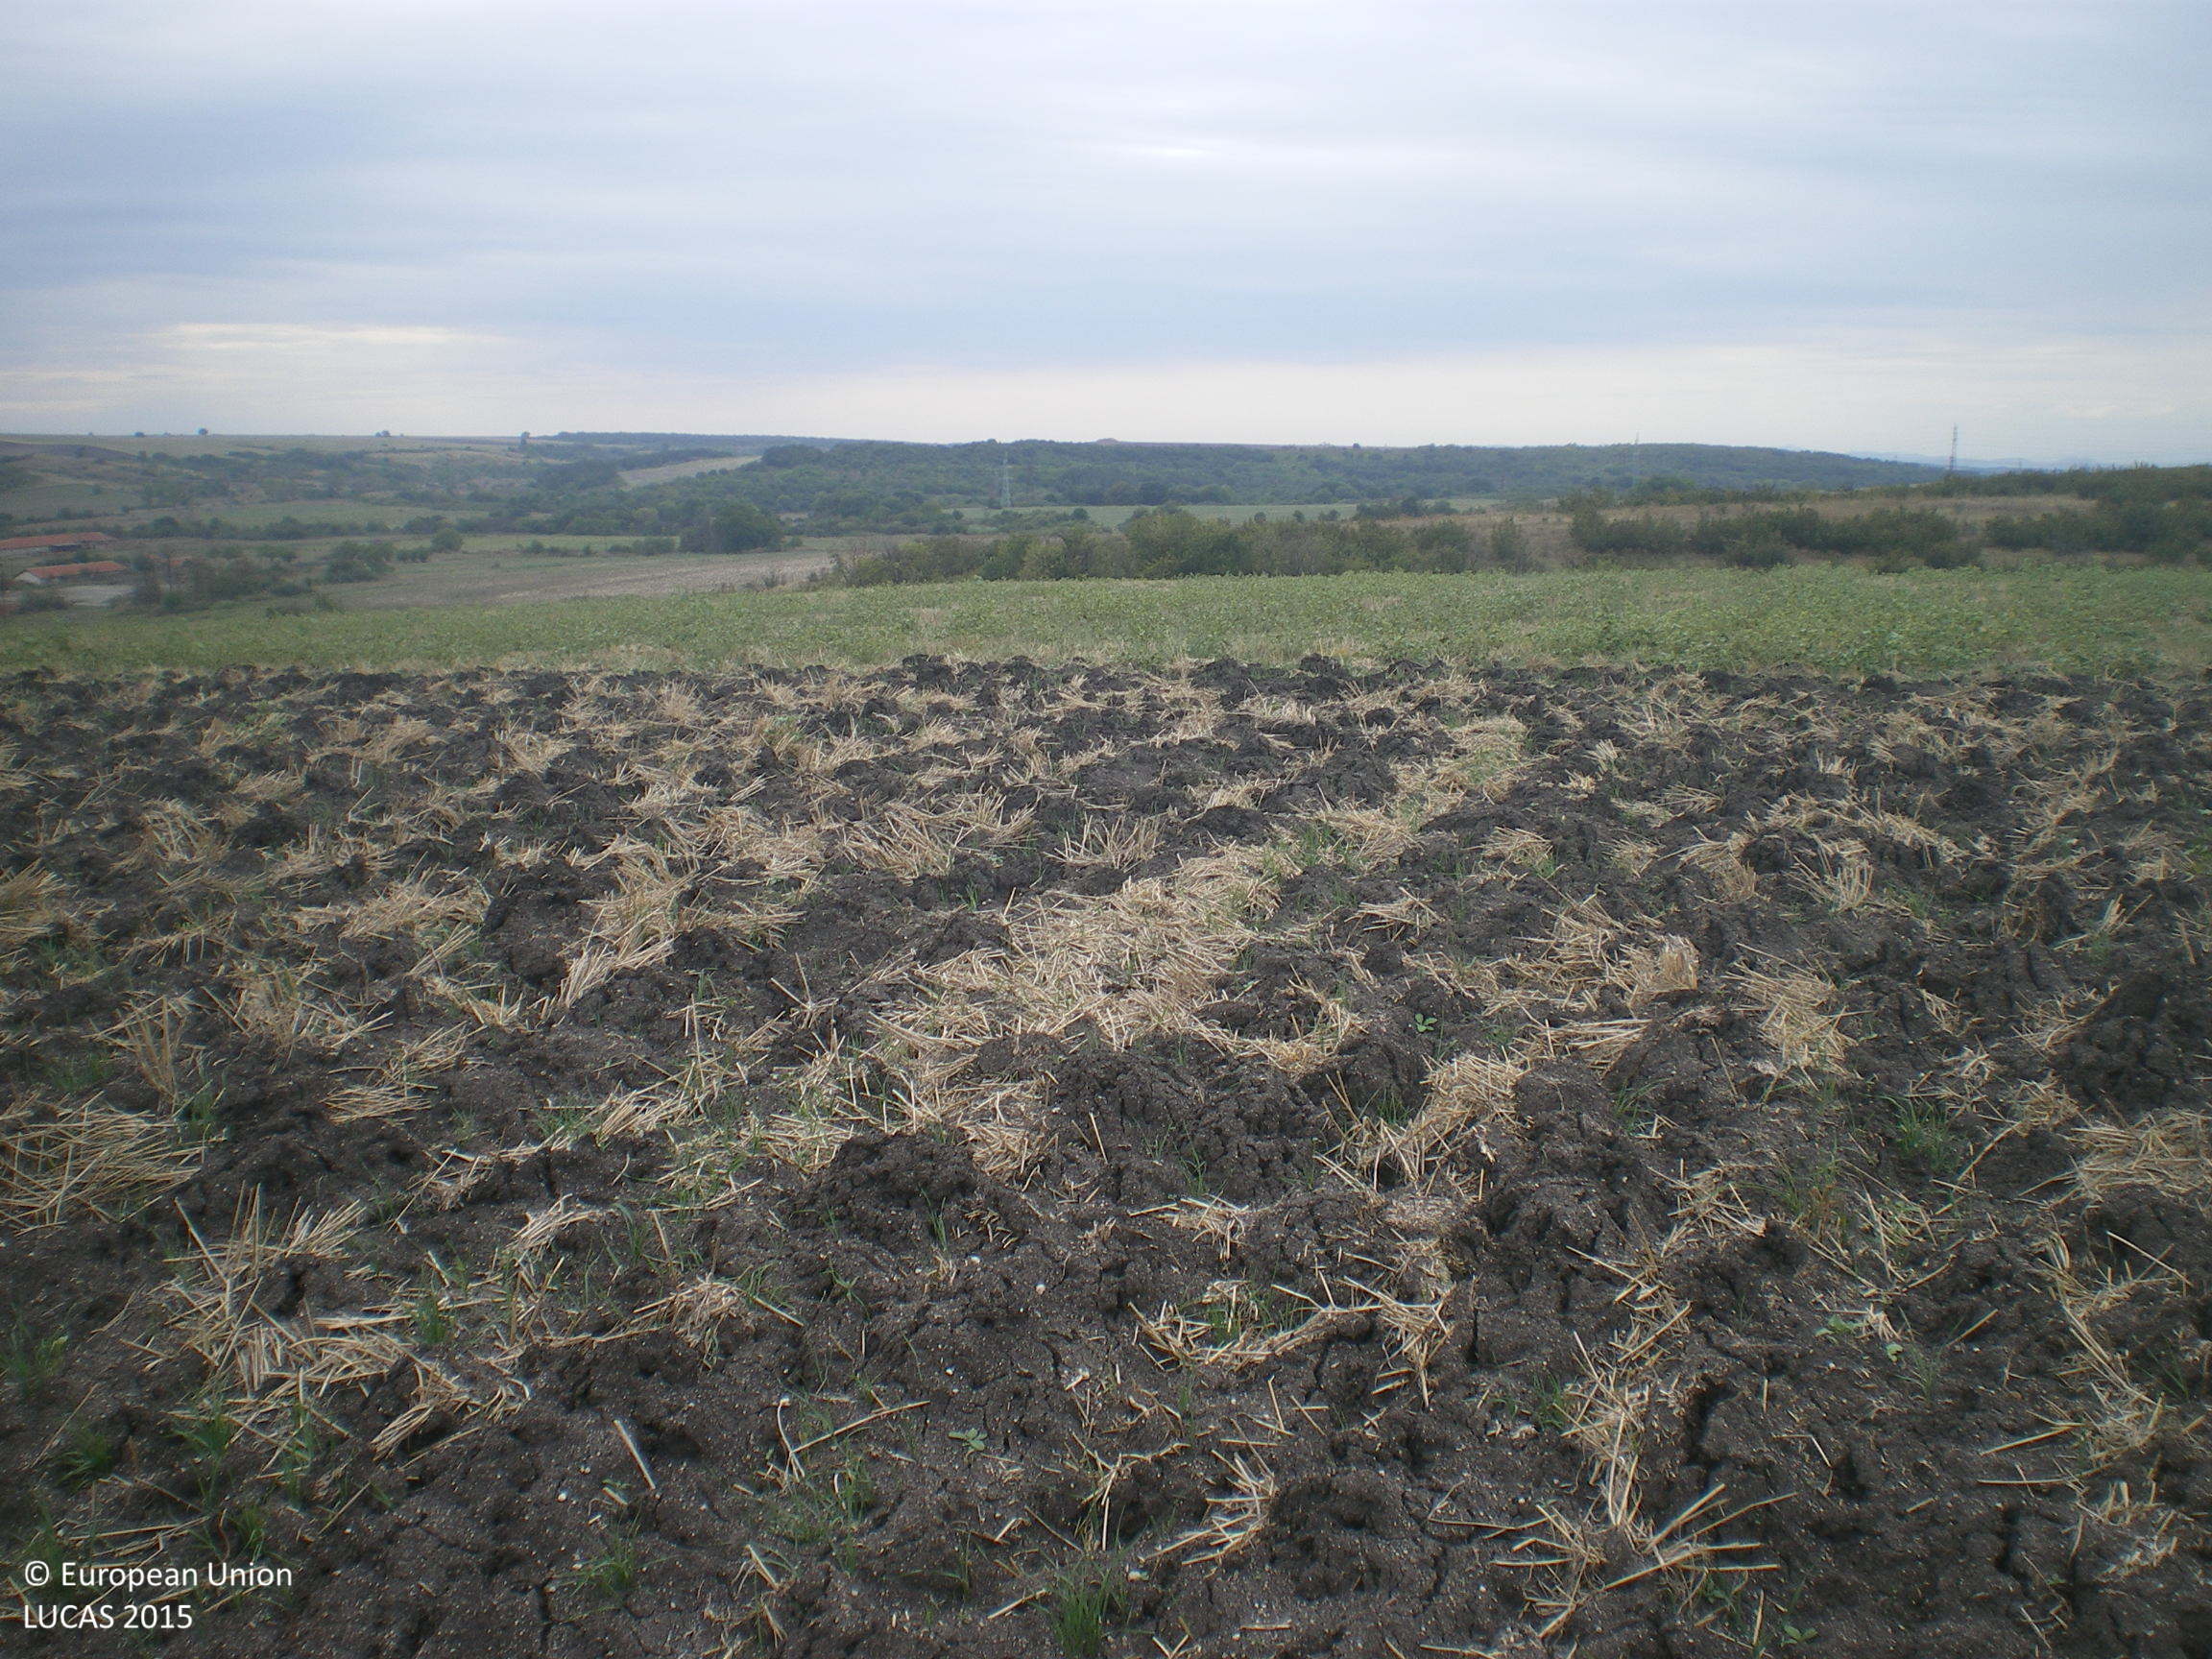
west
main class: Cropland
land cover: Common wheat
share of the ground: < 10 %
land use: Agriculture (excluding fallow land and kitchen gardens)
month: September
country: BG
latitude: 42.2041
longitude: 25.8553
